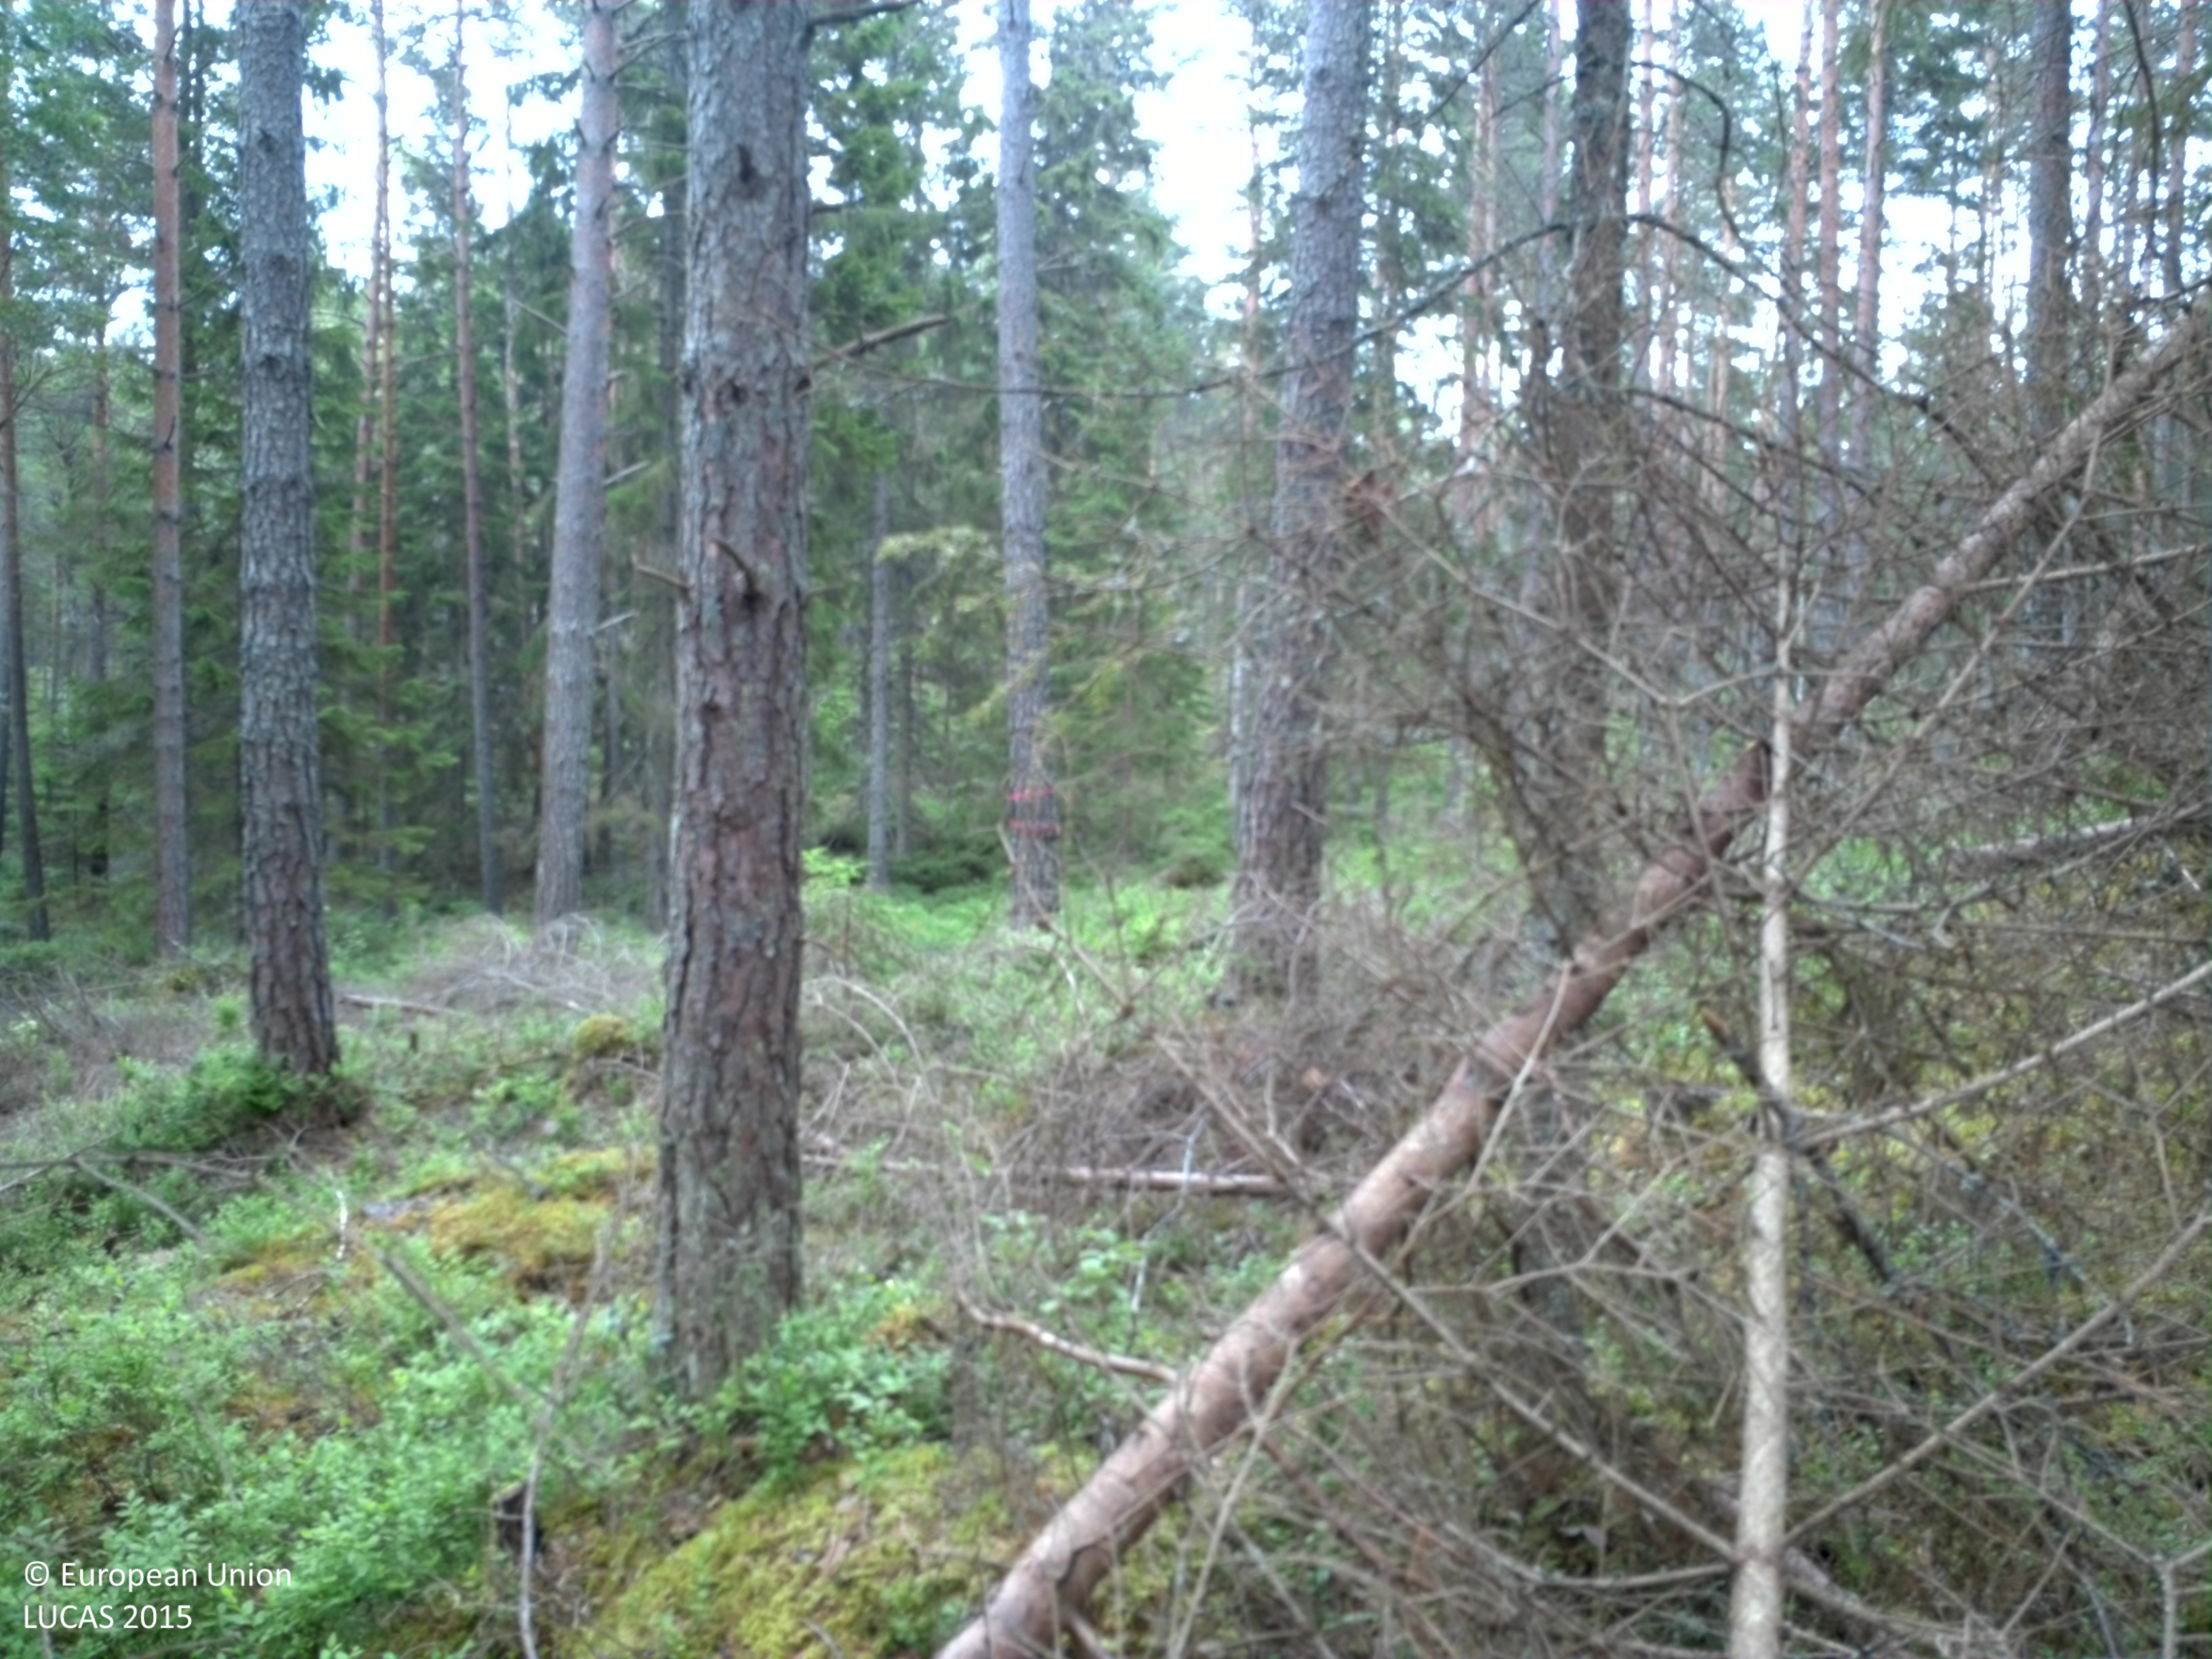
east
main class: Woodland
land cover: Pine dominated coniferous woodland
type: boreal forest
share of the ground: 50 - 75 %
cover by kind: coniferous forest trees 60 %, shrubs 35 %, lichens and mosses 5 %
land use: Forestry
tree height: > 5 m
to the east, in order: Pine dominated coniferous woodland; Ditches and canals; Grass margins; Paved roads, cycling and walking lanes; Grass margins; Pine dominated coniferous woodland
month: July
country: SE
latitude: 58.7982
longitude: 14.3367
